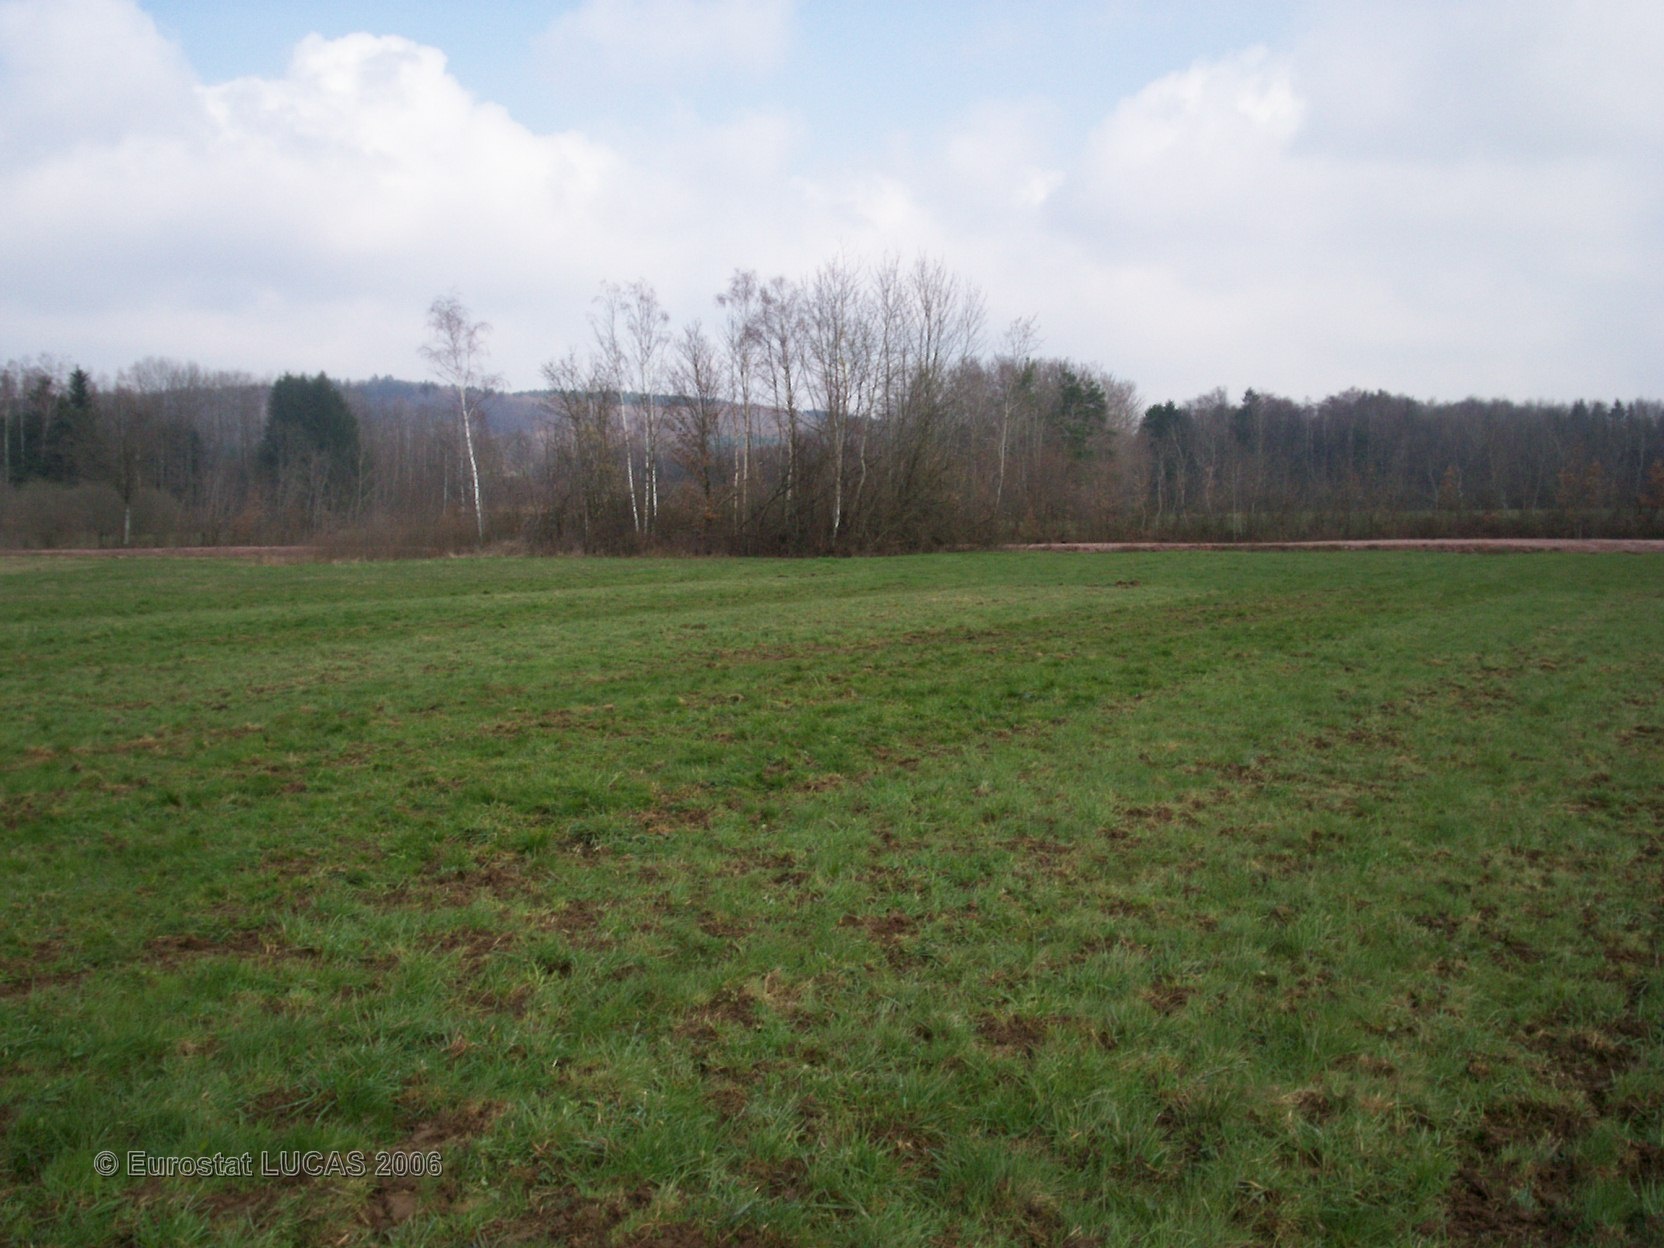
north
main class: Grassland
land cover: Grassland without tree/shrub cover
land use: Agriculture (excluding fallow land and kitchen gardens)
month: April
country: FR
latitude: 48.0879
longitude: 6.2550
